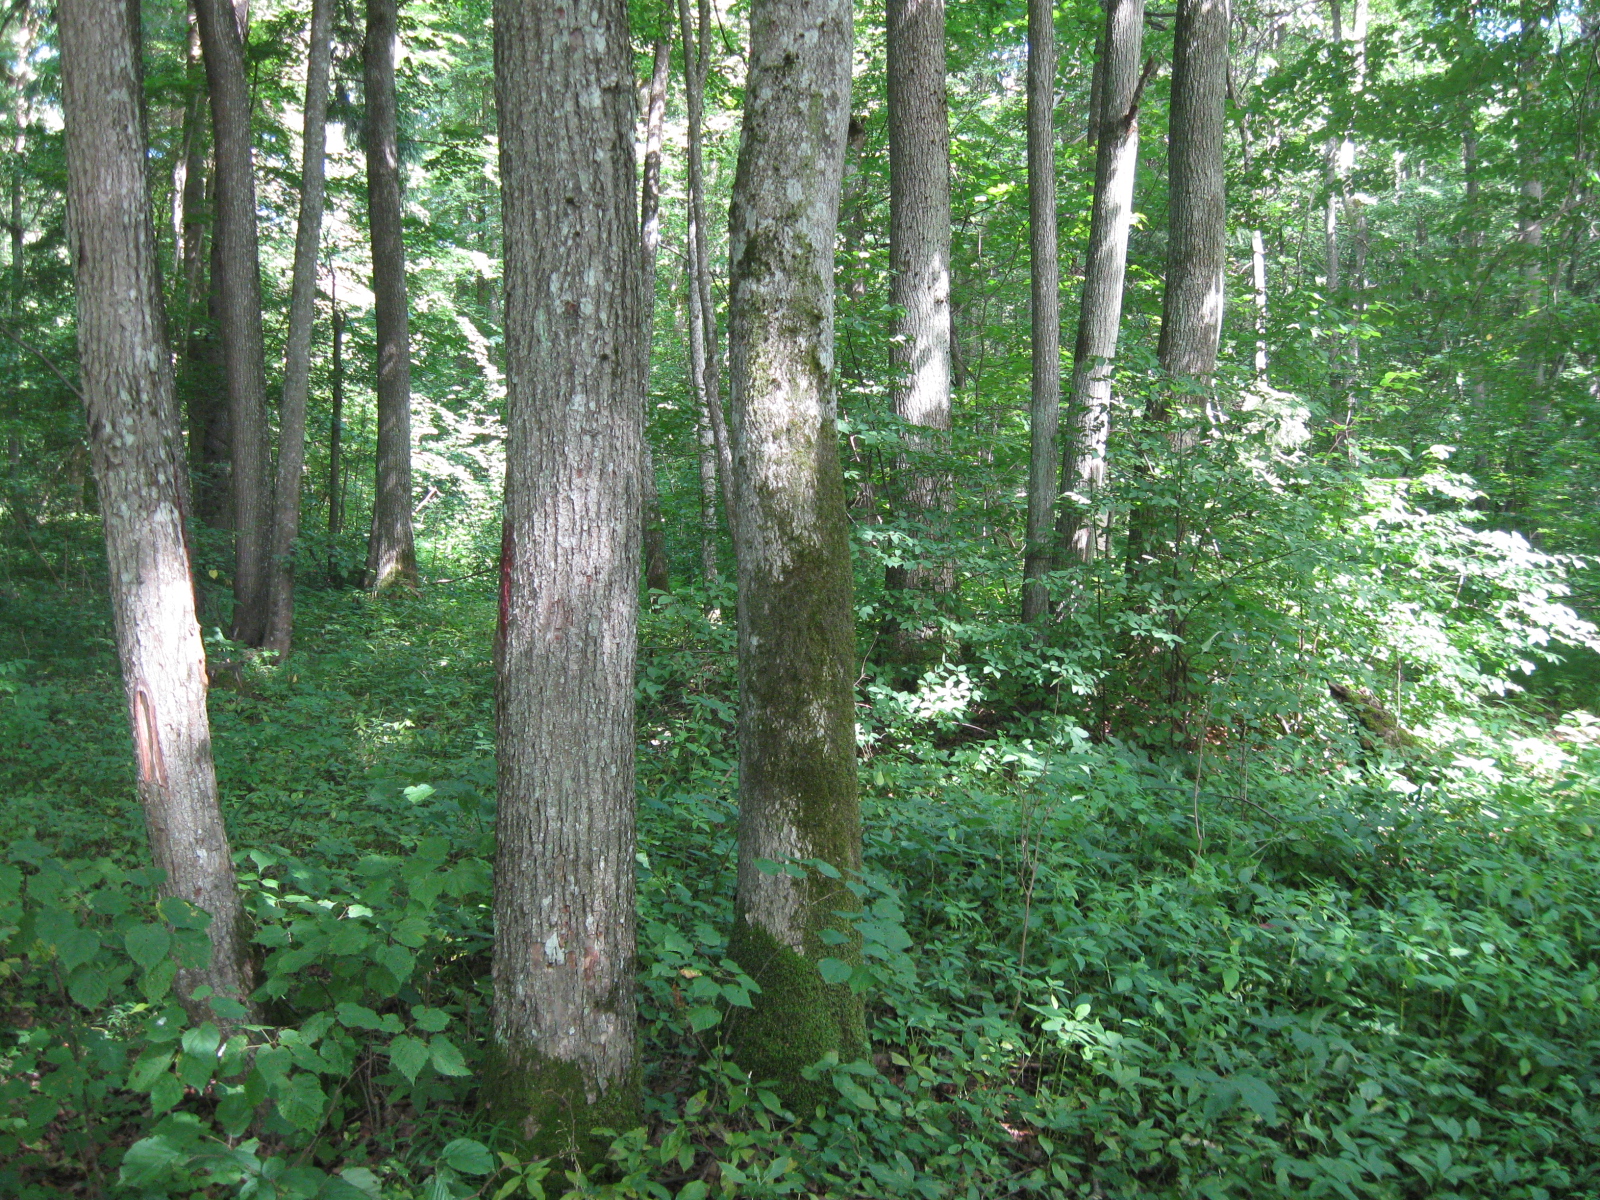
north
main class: Woodland
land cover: Other mixed woodland
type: hemiboreal forest and nemoral coniferous forest and mixed broadleaved-coniferous forest
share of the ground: > 75 %
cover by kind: broadleaved forest trees 65 %, coniferous forest trees 30 %, herbaceous plants 5 %
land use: Forestry
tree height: > 5 m
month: July
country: LT
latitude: 54.9742
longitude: 23.6921
